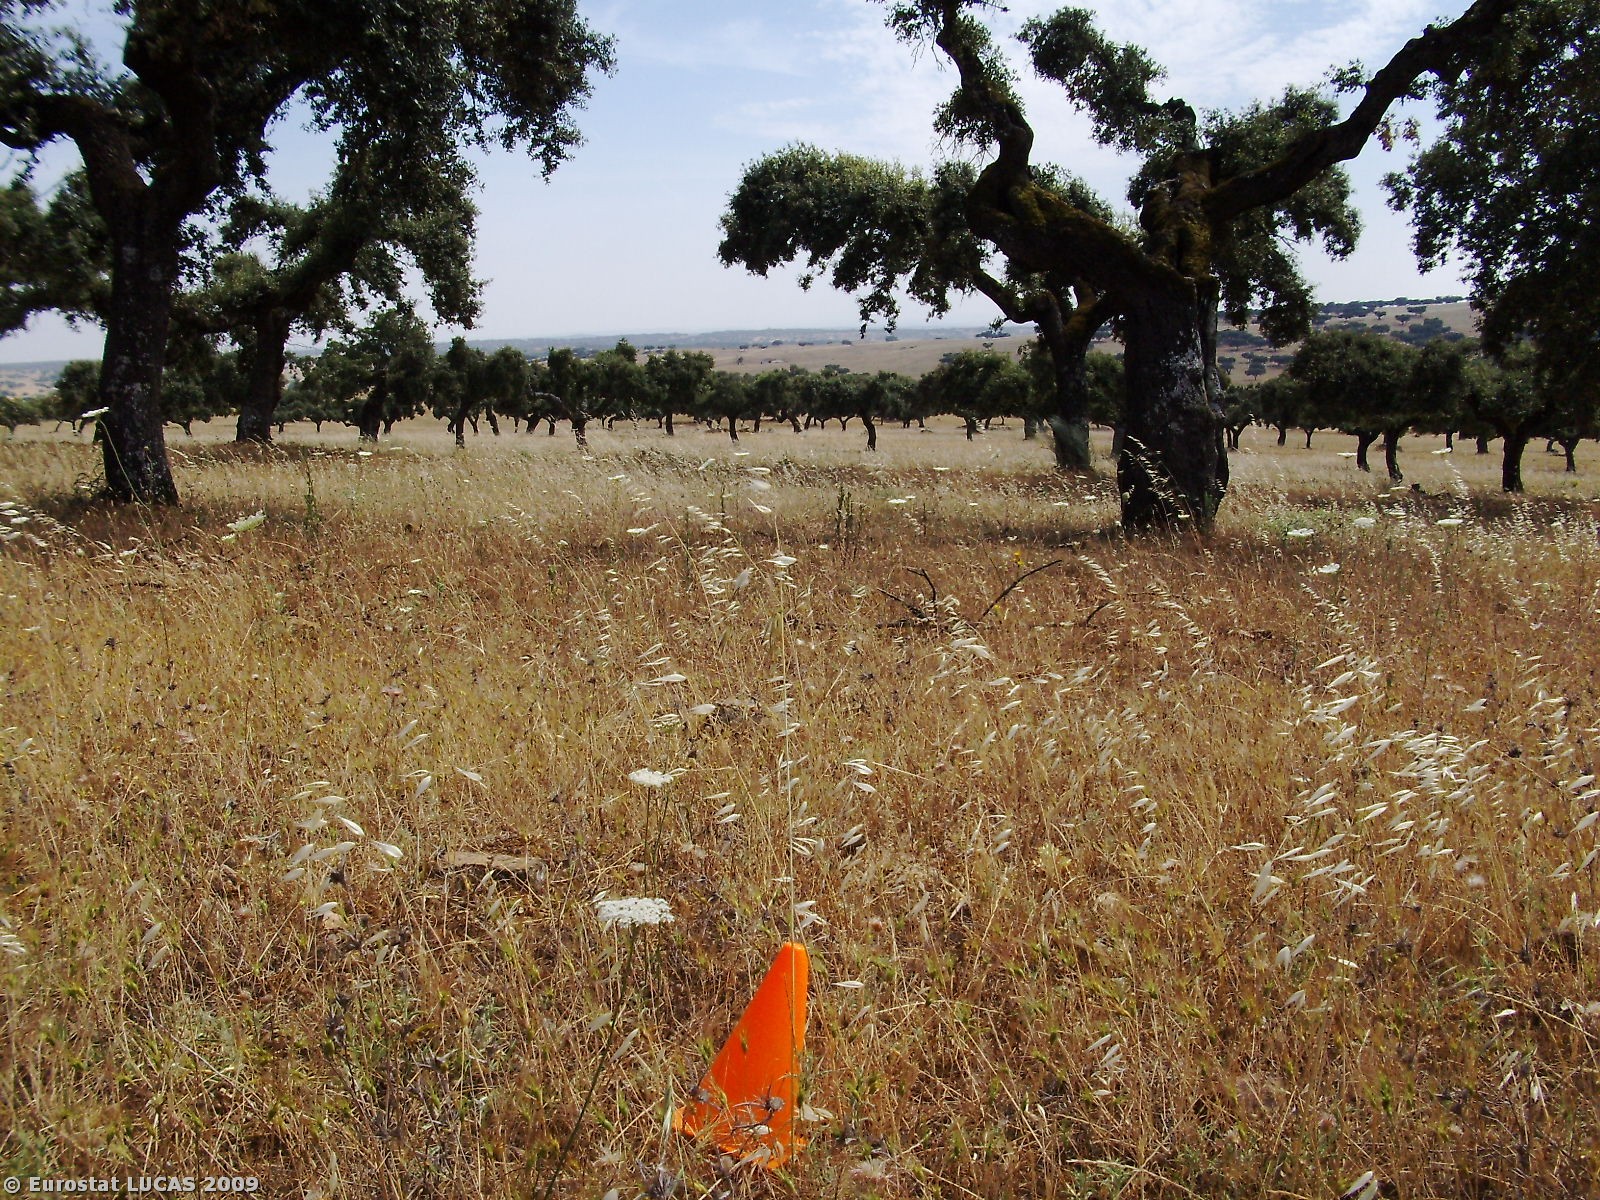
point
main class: Woodland
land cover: Broadleaved woodland
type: broadleaved evergreen forest
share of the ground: 10 - 25 %
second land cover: Spontaneously vegetated surfaces
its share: 50 - 75 %
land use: Forestry
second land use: Fallow land
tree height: > 5 m
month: June
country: PT
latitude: 39.1101
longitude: -7.3722
